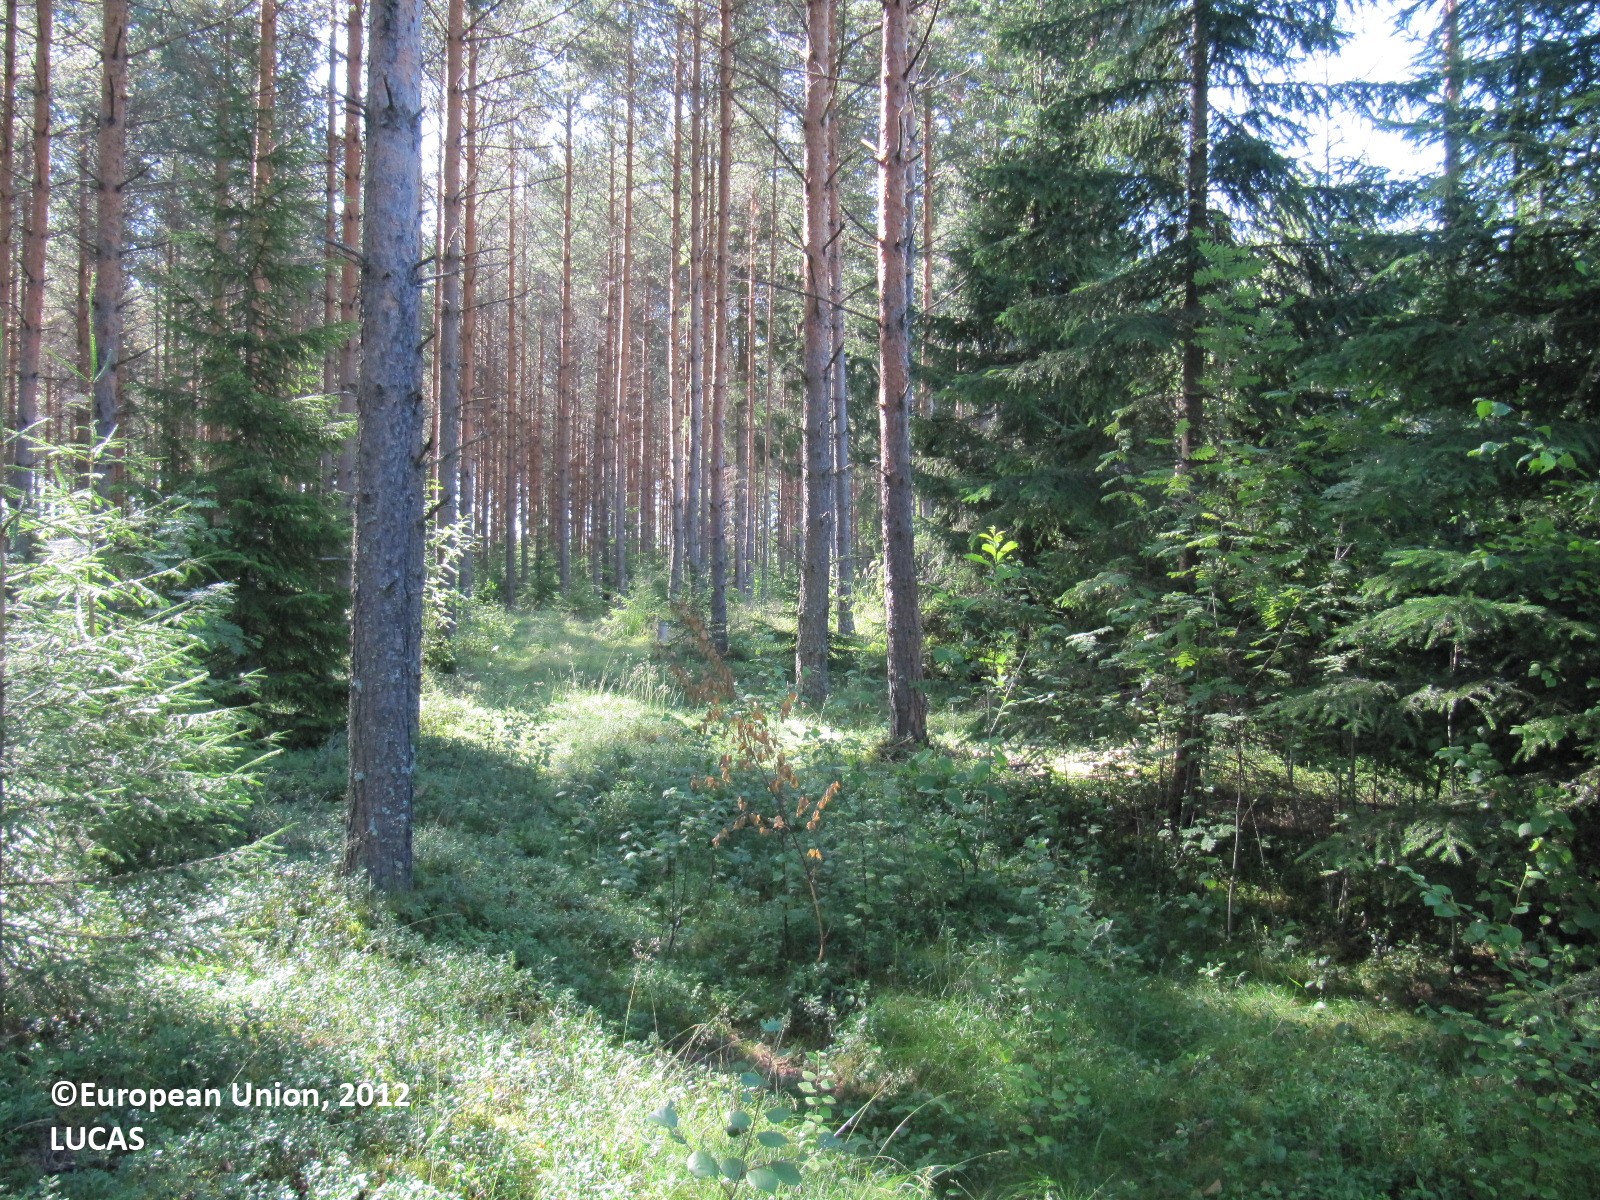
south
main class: Woodland
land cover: Pine dominated mixed woodland
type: boreal forest
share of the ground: > 75 %
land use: Forestry
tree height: > 5 m
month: July
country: FI
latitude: 60.9048
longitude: 24.5770
